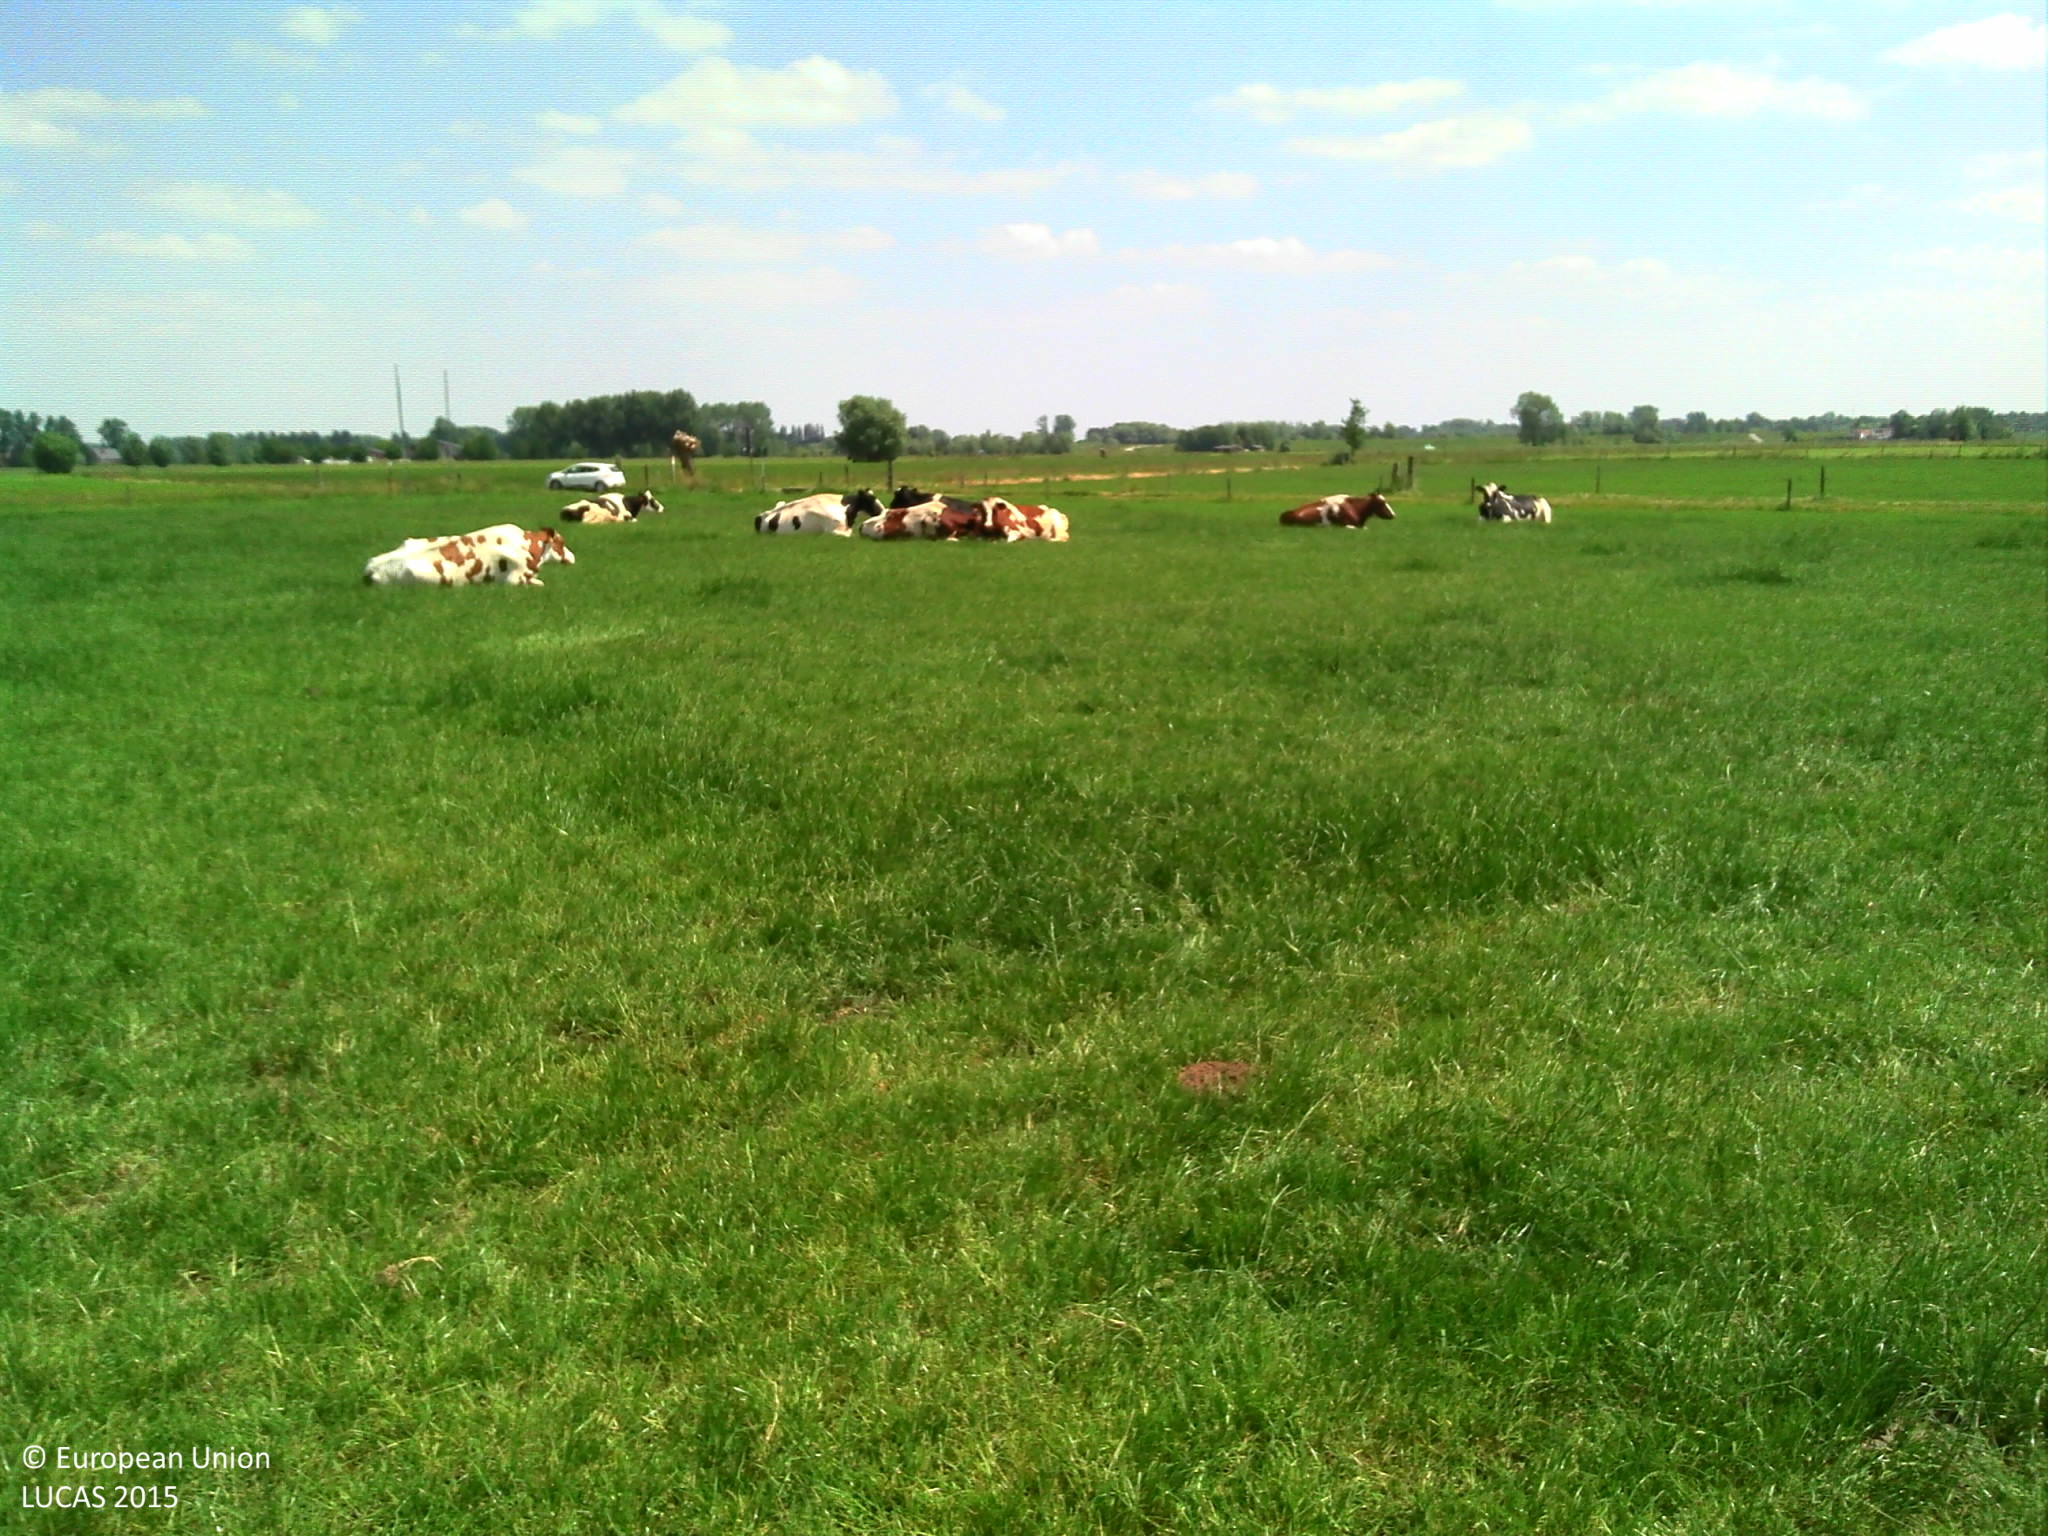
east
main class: Grassland
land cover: Grassland without tree/shrub cover
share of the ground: > 75 %
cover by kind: herbaceous plants 100 %
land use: Agriculture (excluding fallow land and kitchen gardens)
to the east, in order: Grassland without tree/shrub cover; Fences; Grass margins; Tracks; Grass margins; Fences; Ditches and canals; Fences; Grassland without tree/shrub cover; Fences; Ditches and canals; Paved roads, cycling and walking lanes; Ditches and canals; Fences; Grassland without tree/shrub cover
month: June
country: BE
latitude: 51.0369
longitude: 4.0188
